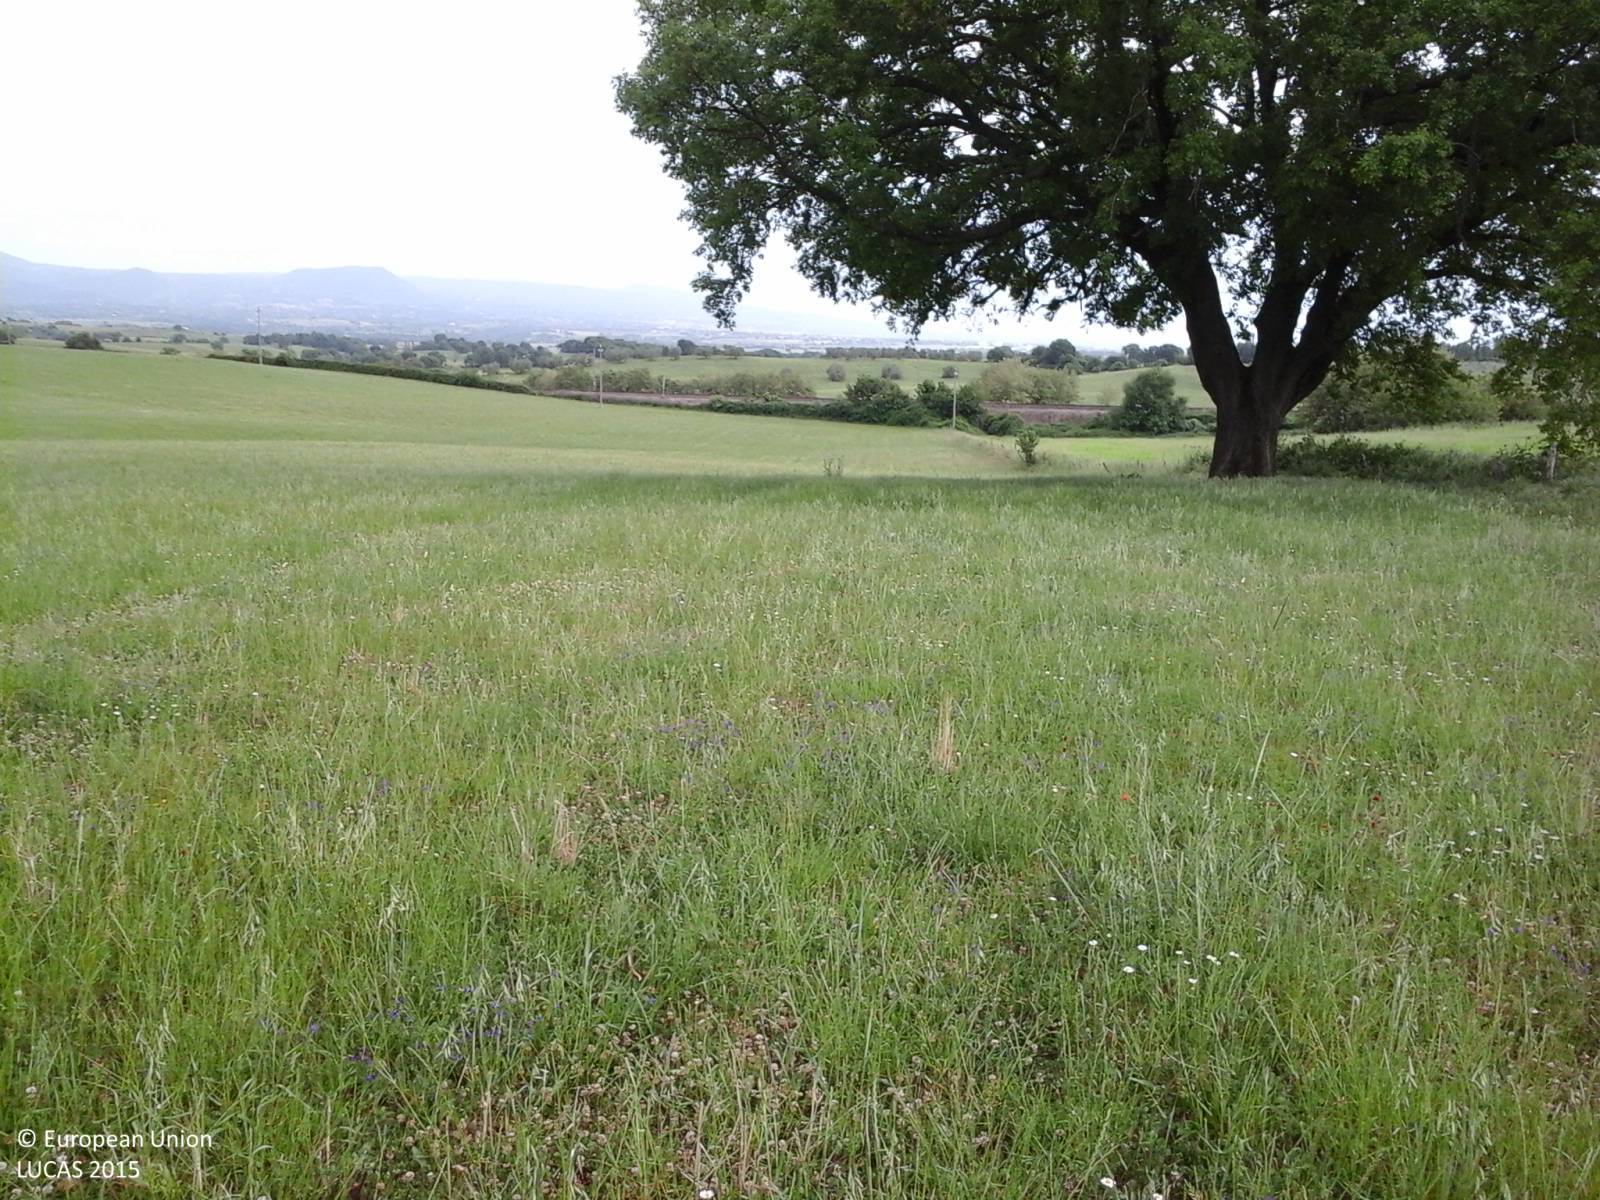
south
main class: Cropland
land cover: Other leguminous and mixtures for fodder
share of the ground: > 75 %
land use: Agriculture (excluding fallow land and kitchen gardens)
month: May
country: IT
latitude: 42.5239
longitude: 12.0989
